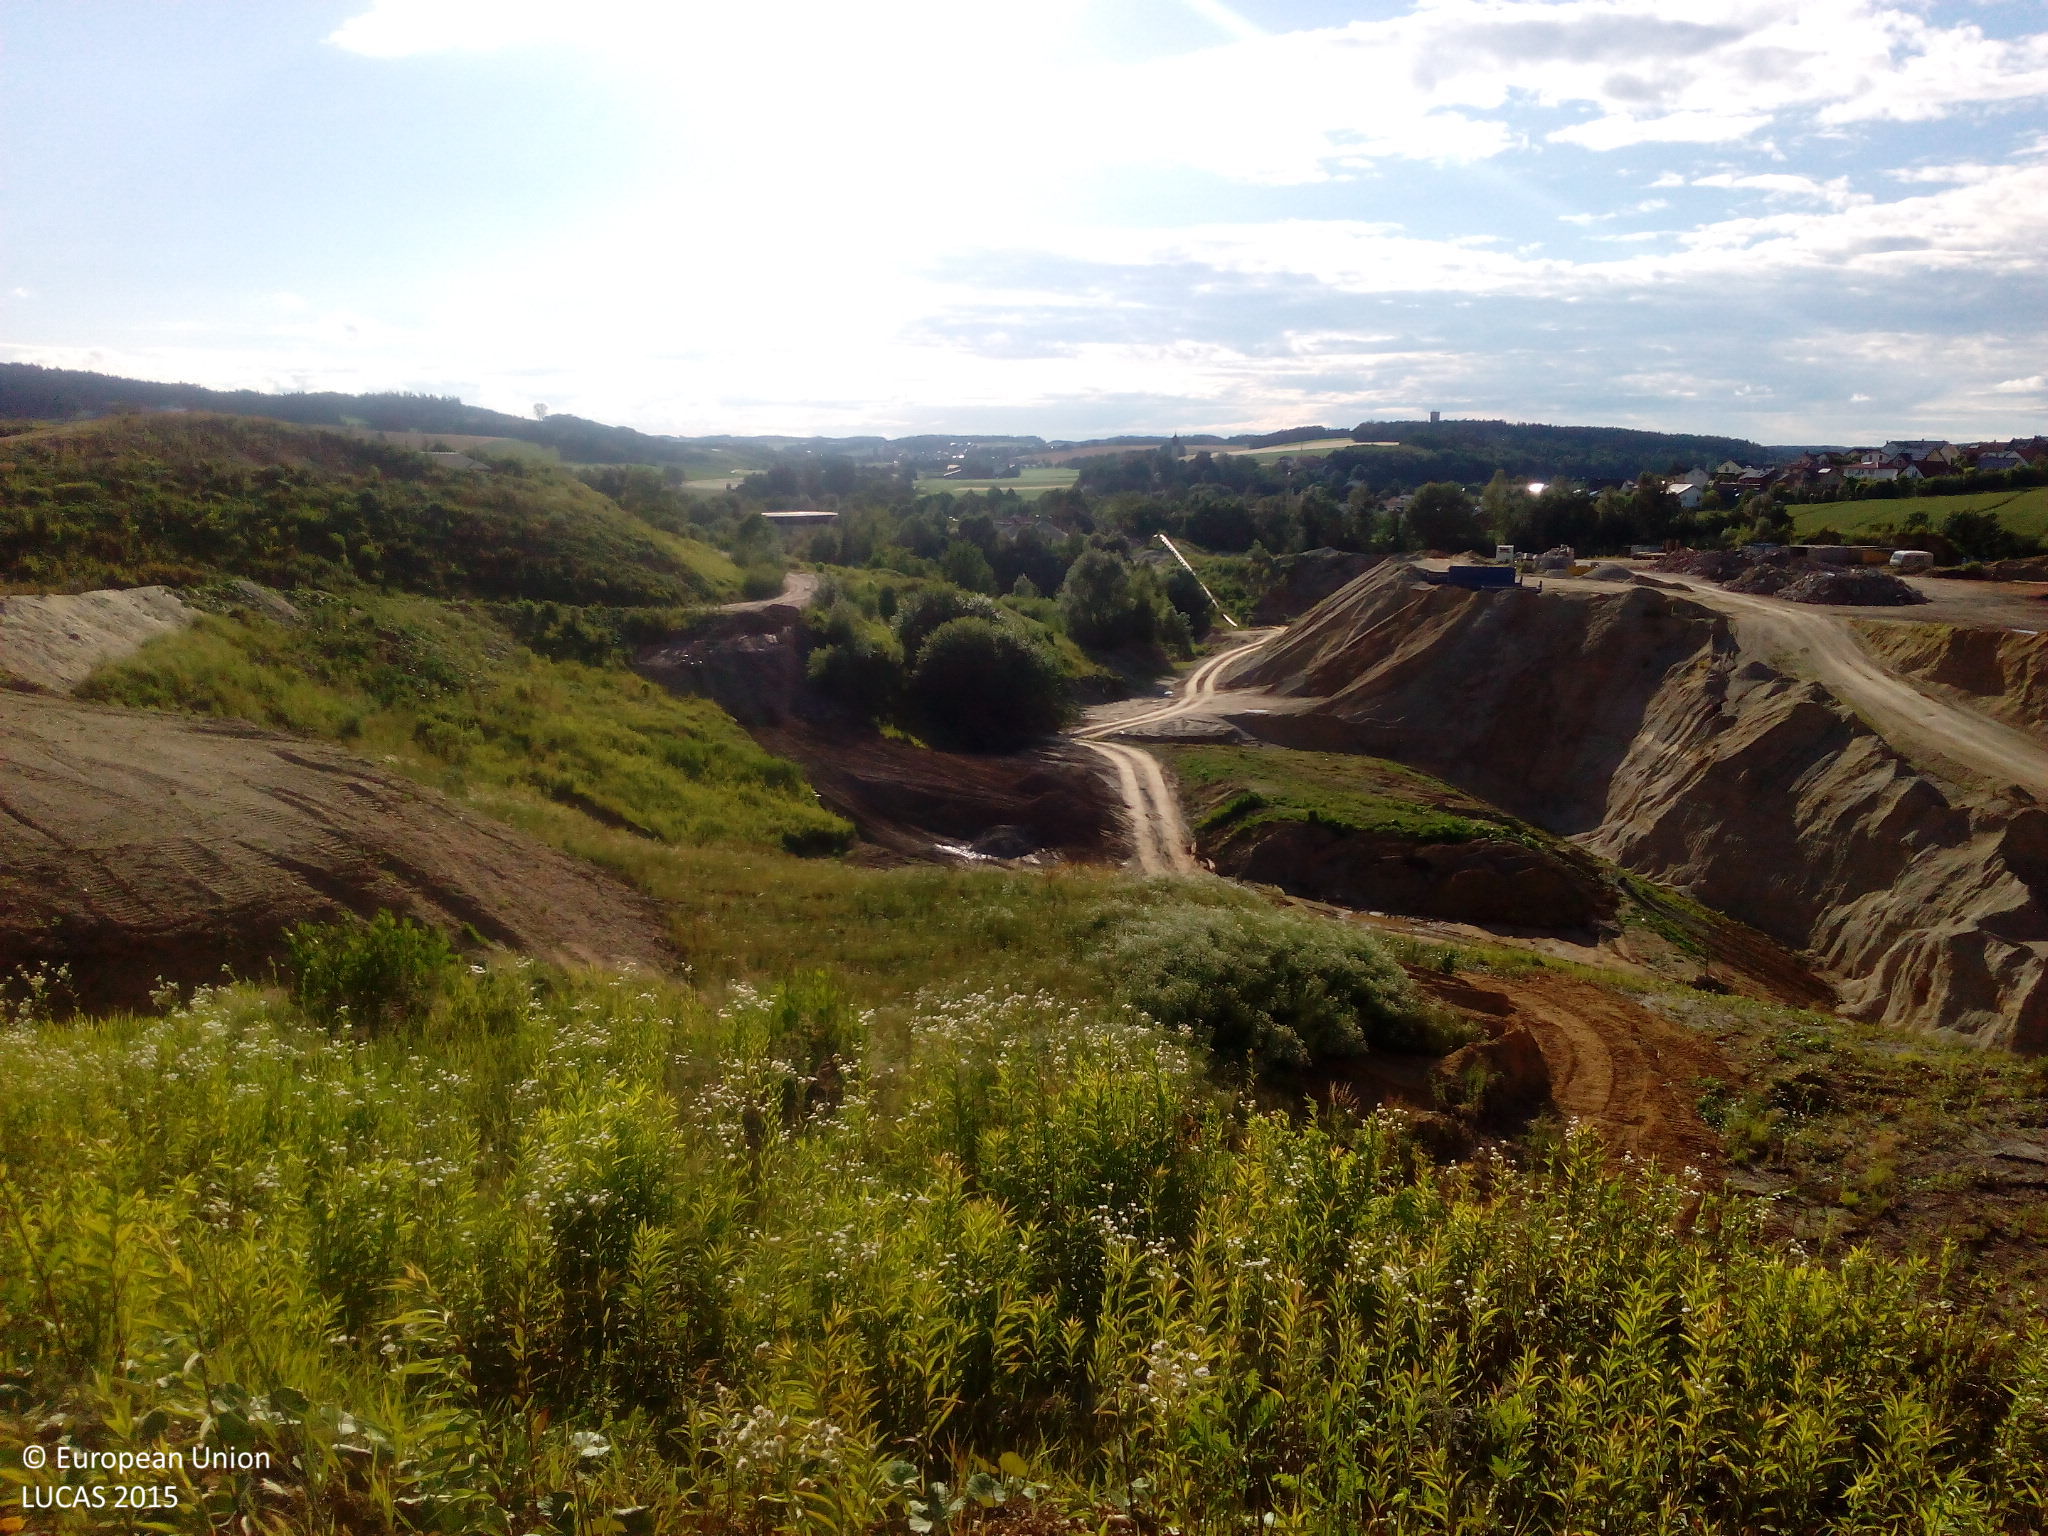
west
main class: Grassland
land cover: Spontaneously vegetated surfaces
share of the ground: 10 - 25 %
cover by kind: unconsolidated bare surface 80 %, herbaceous plants 20 %
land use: Mining and quarrying
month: June
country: DE
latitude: 48.5821
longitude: 12.0732
